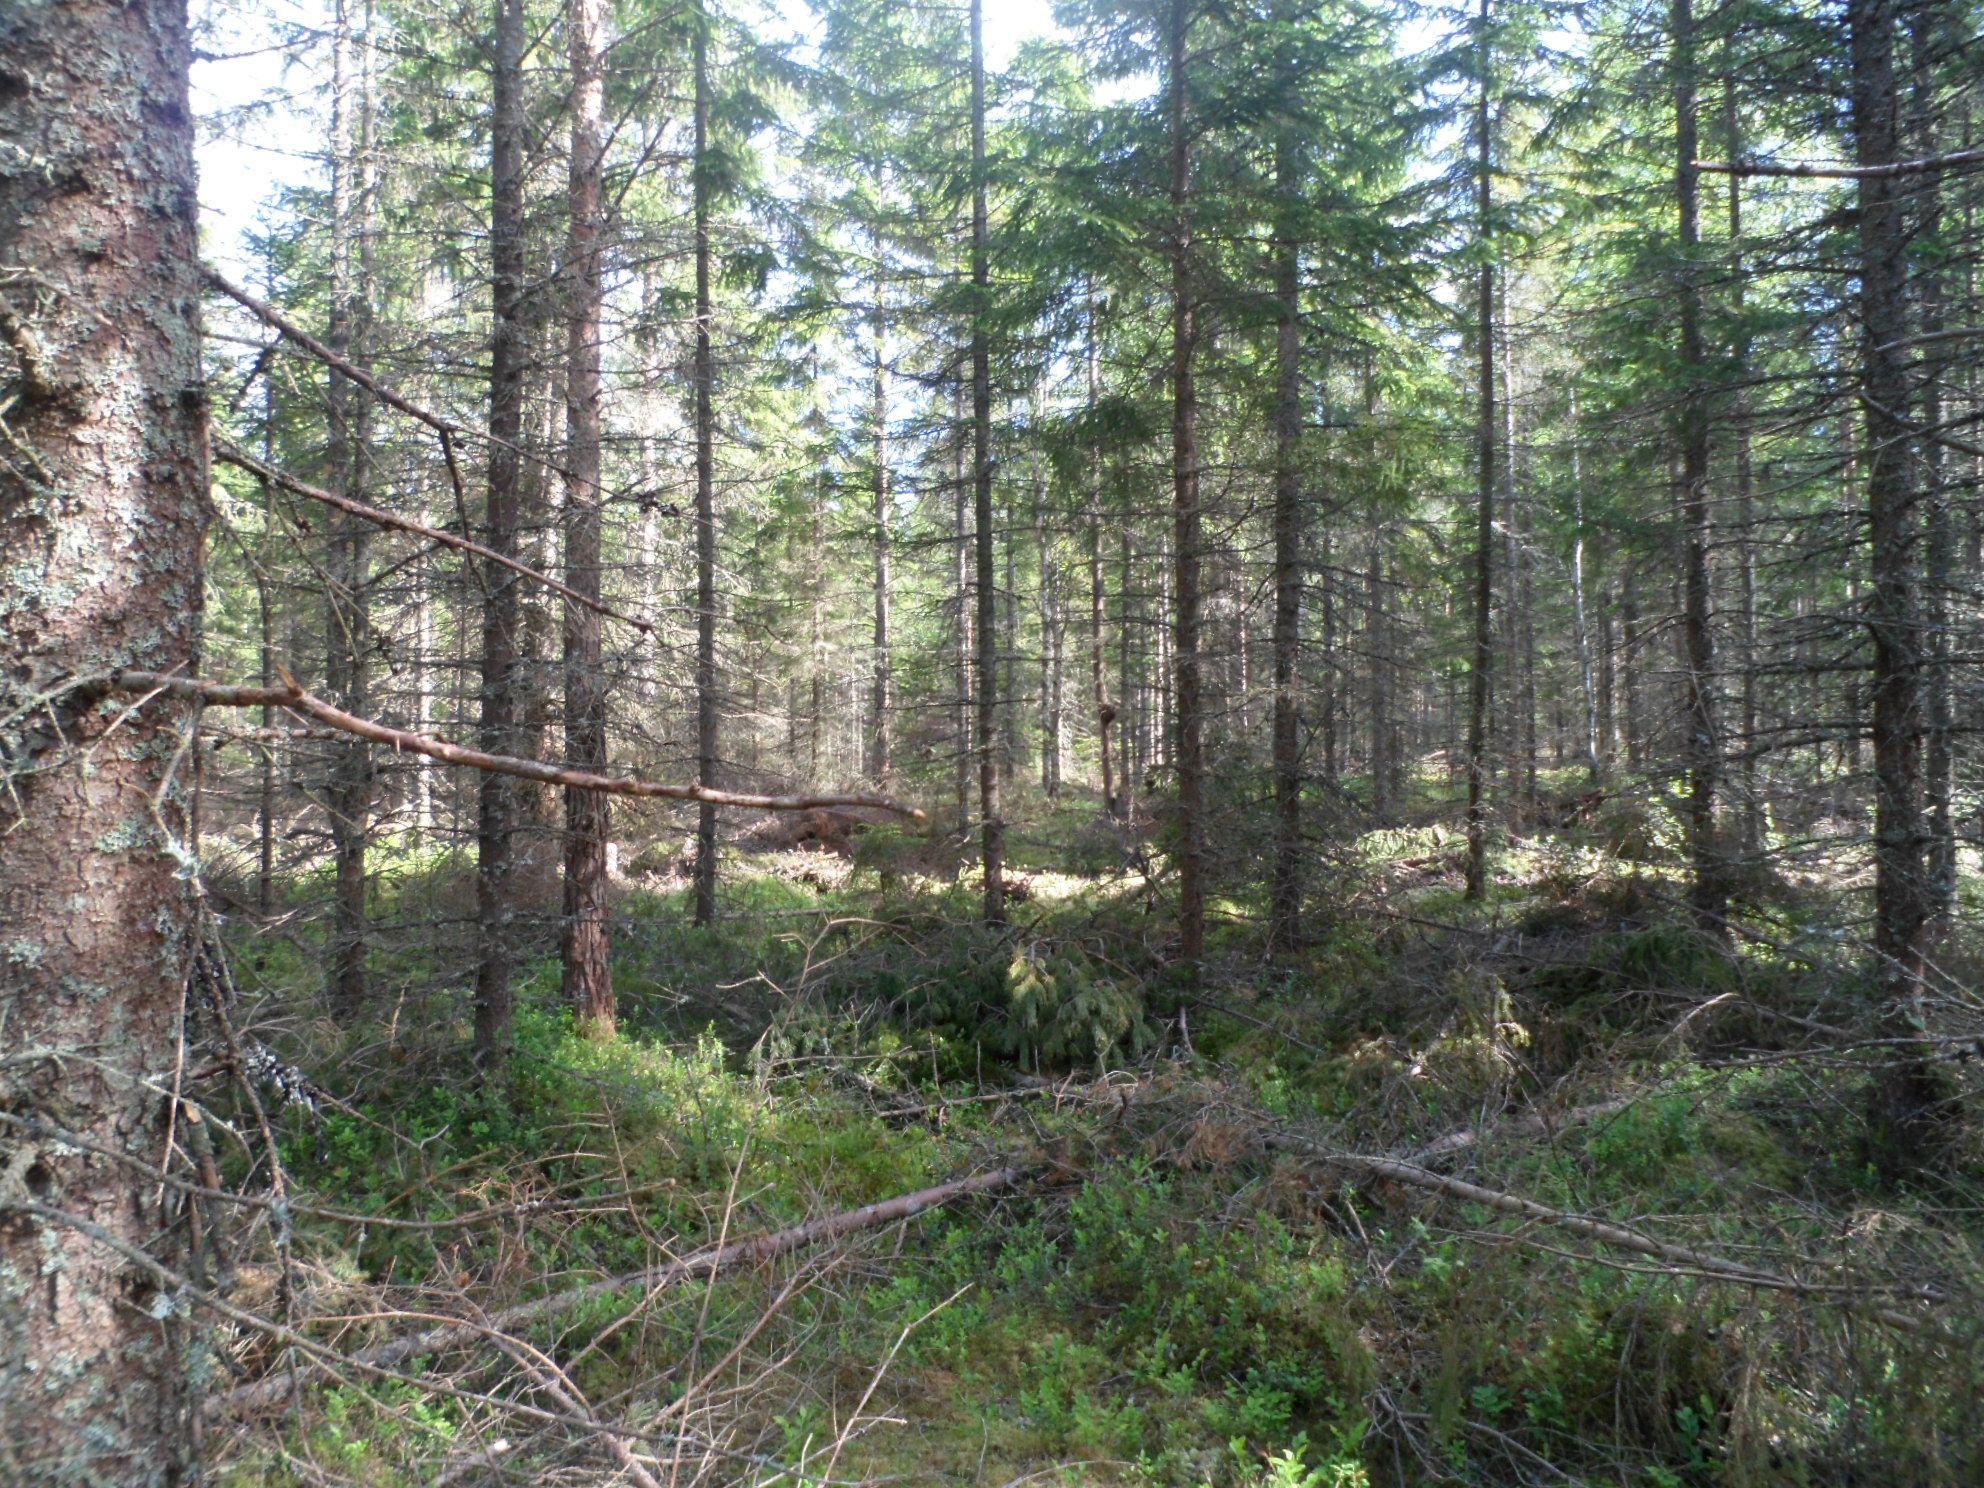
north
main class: Woodland
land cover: Spruce dominated coniferous woodland
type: boreal forest
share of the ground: 50 - 75 %
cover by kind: coniferous forest trees 55 %, lichens and mosses 25 %, shrubs 10 %, unconsolidated bare surface 10 %
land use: Forestry
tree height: > 5 m
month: June
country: SE
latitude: 57.0259
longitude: 15.4838
